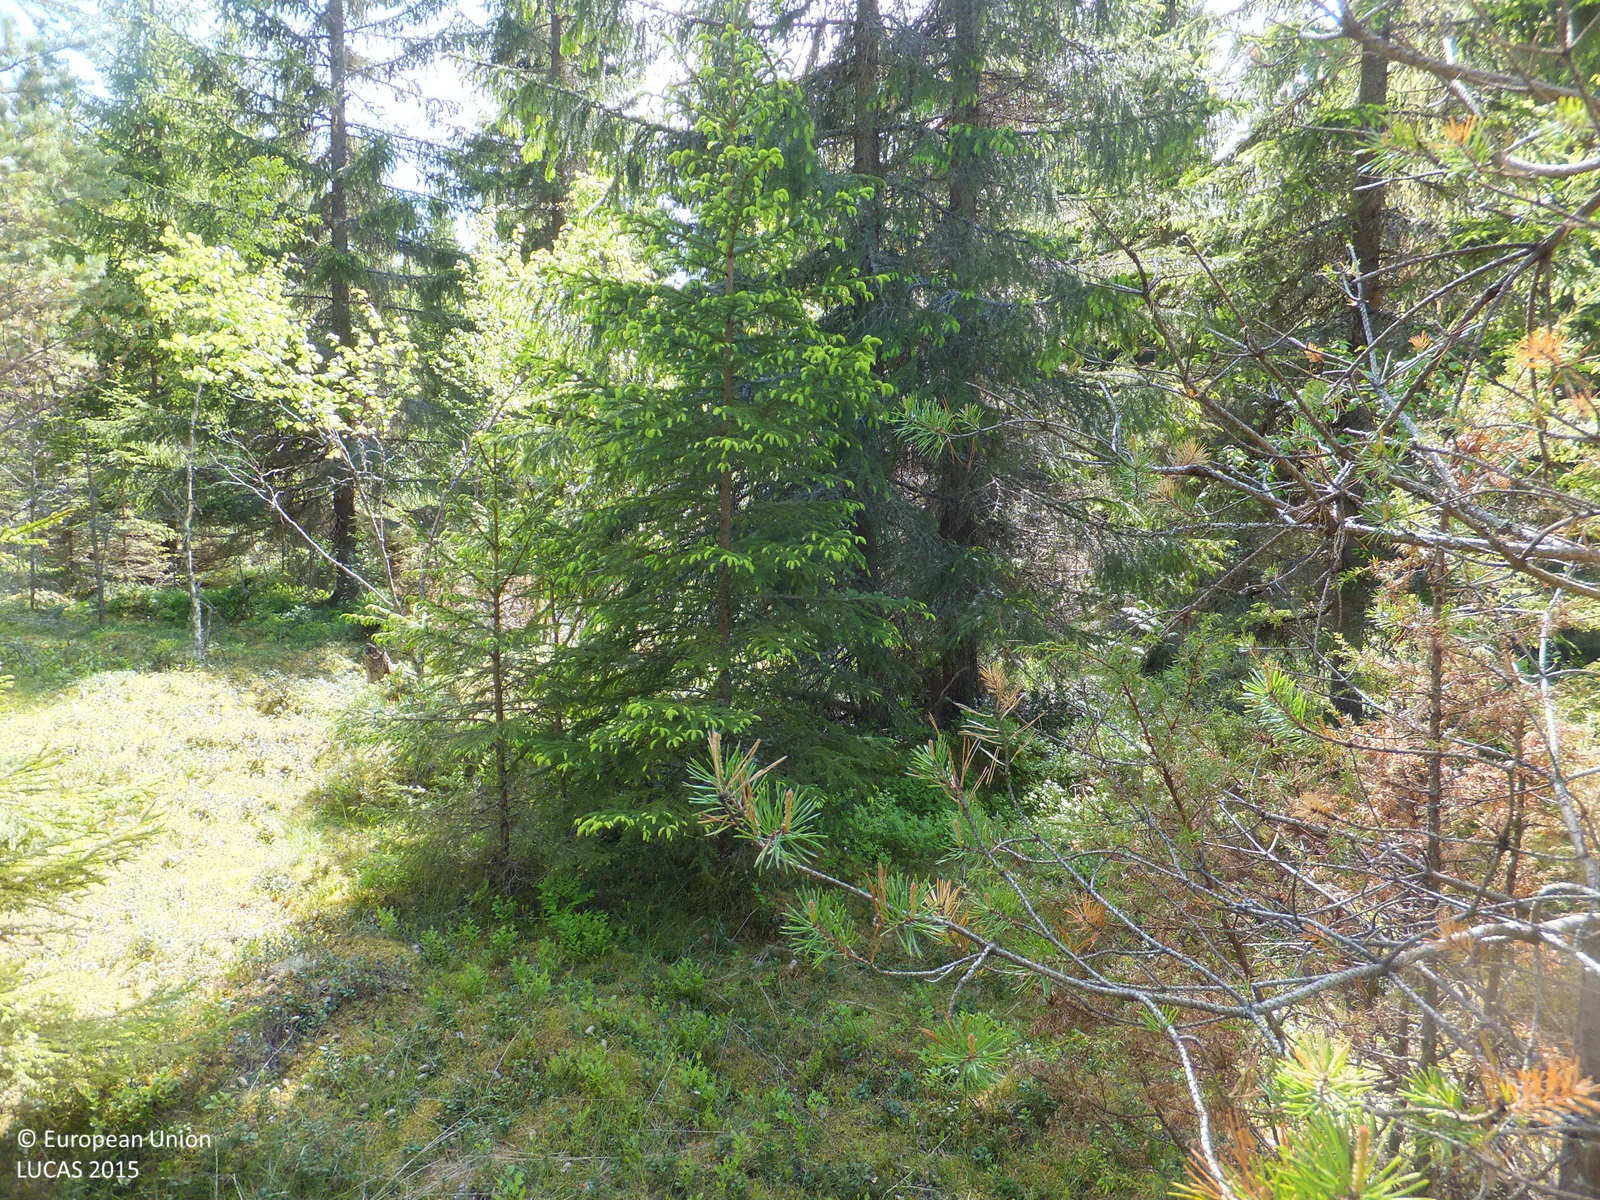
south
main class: Woodland
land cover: Pine dominated coniferous woodland
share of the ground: > 75 %
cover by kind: coniferous forest trees 80 %, broadleaved forest trees 10 %, shrubs 5 %, lichens and mosses 5 %
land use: Forestry
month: June
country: FI
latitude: 63.2928
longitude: 22.5544
